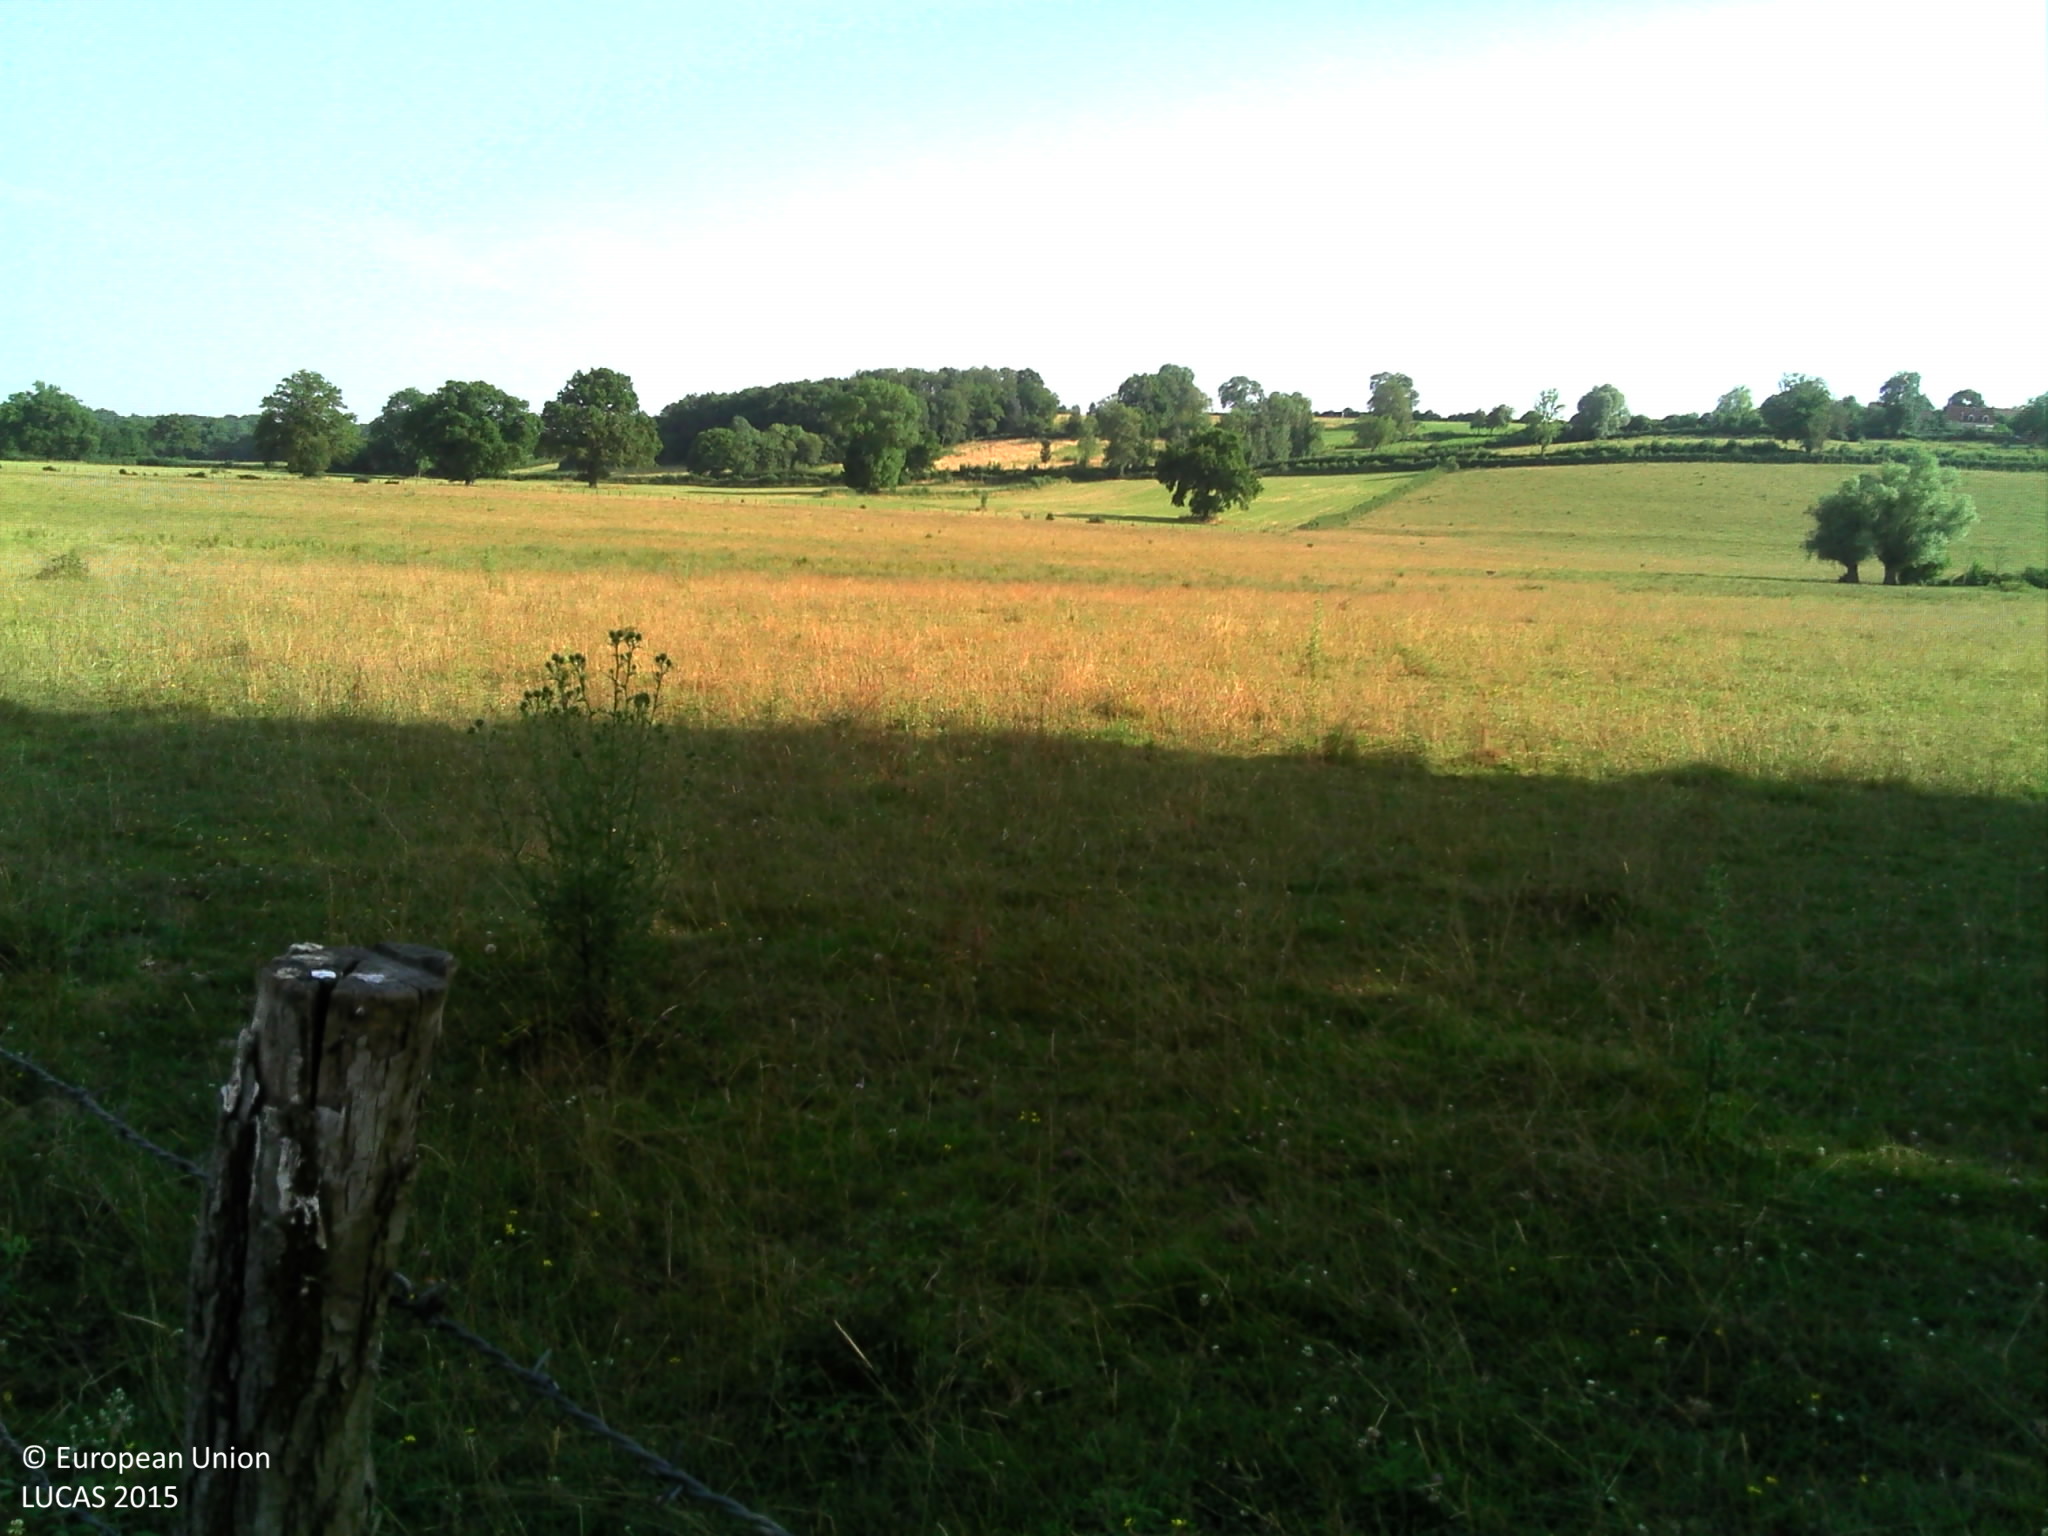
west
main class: Grassland
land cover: Grassland without tree/shrub cover
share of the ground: > 75 %
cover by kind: herbaceous plants 100 %
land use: Agriculture (excluding fallow land and kitchen gardens)
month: July
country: FR
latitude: 47.3517
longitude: 3.6029
